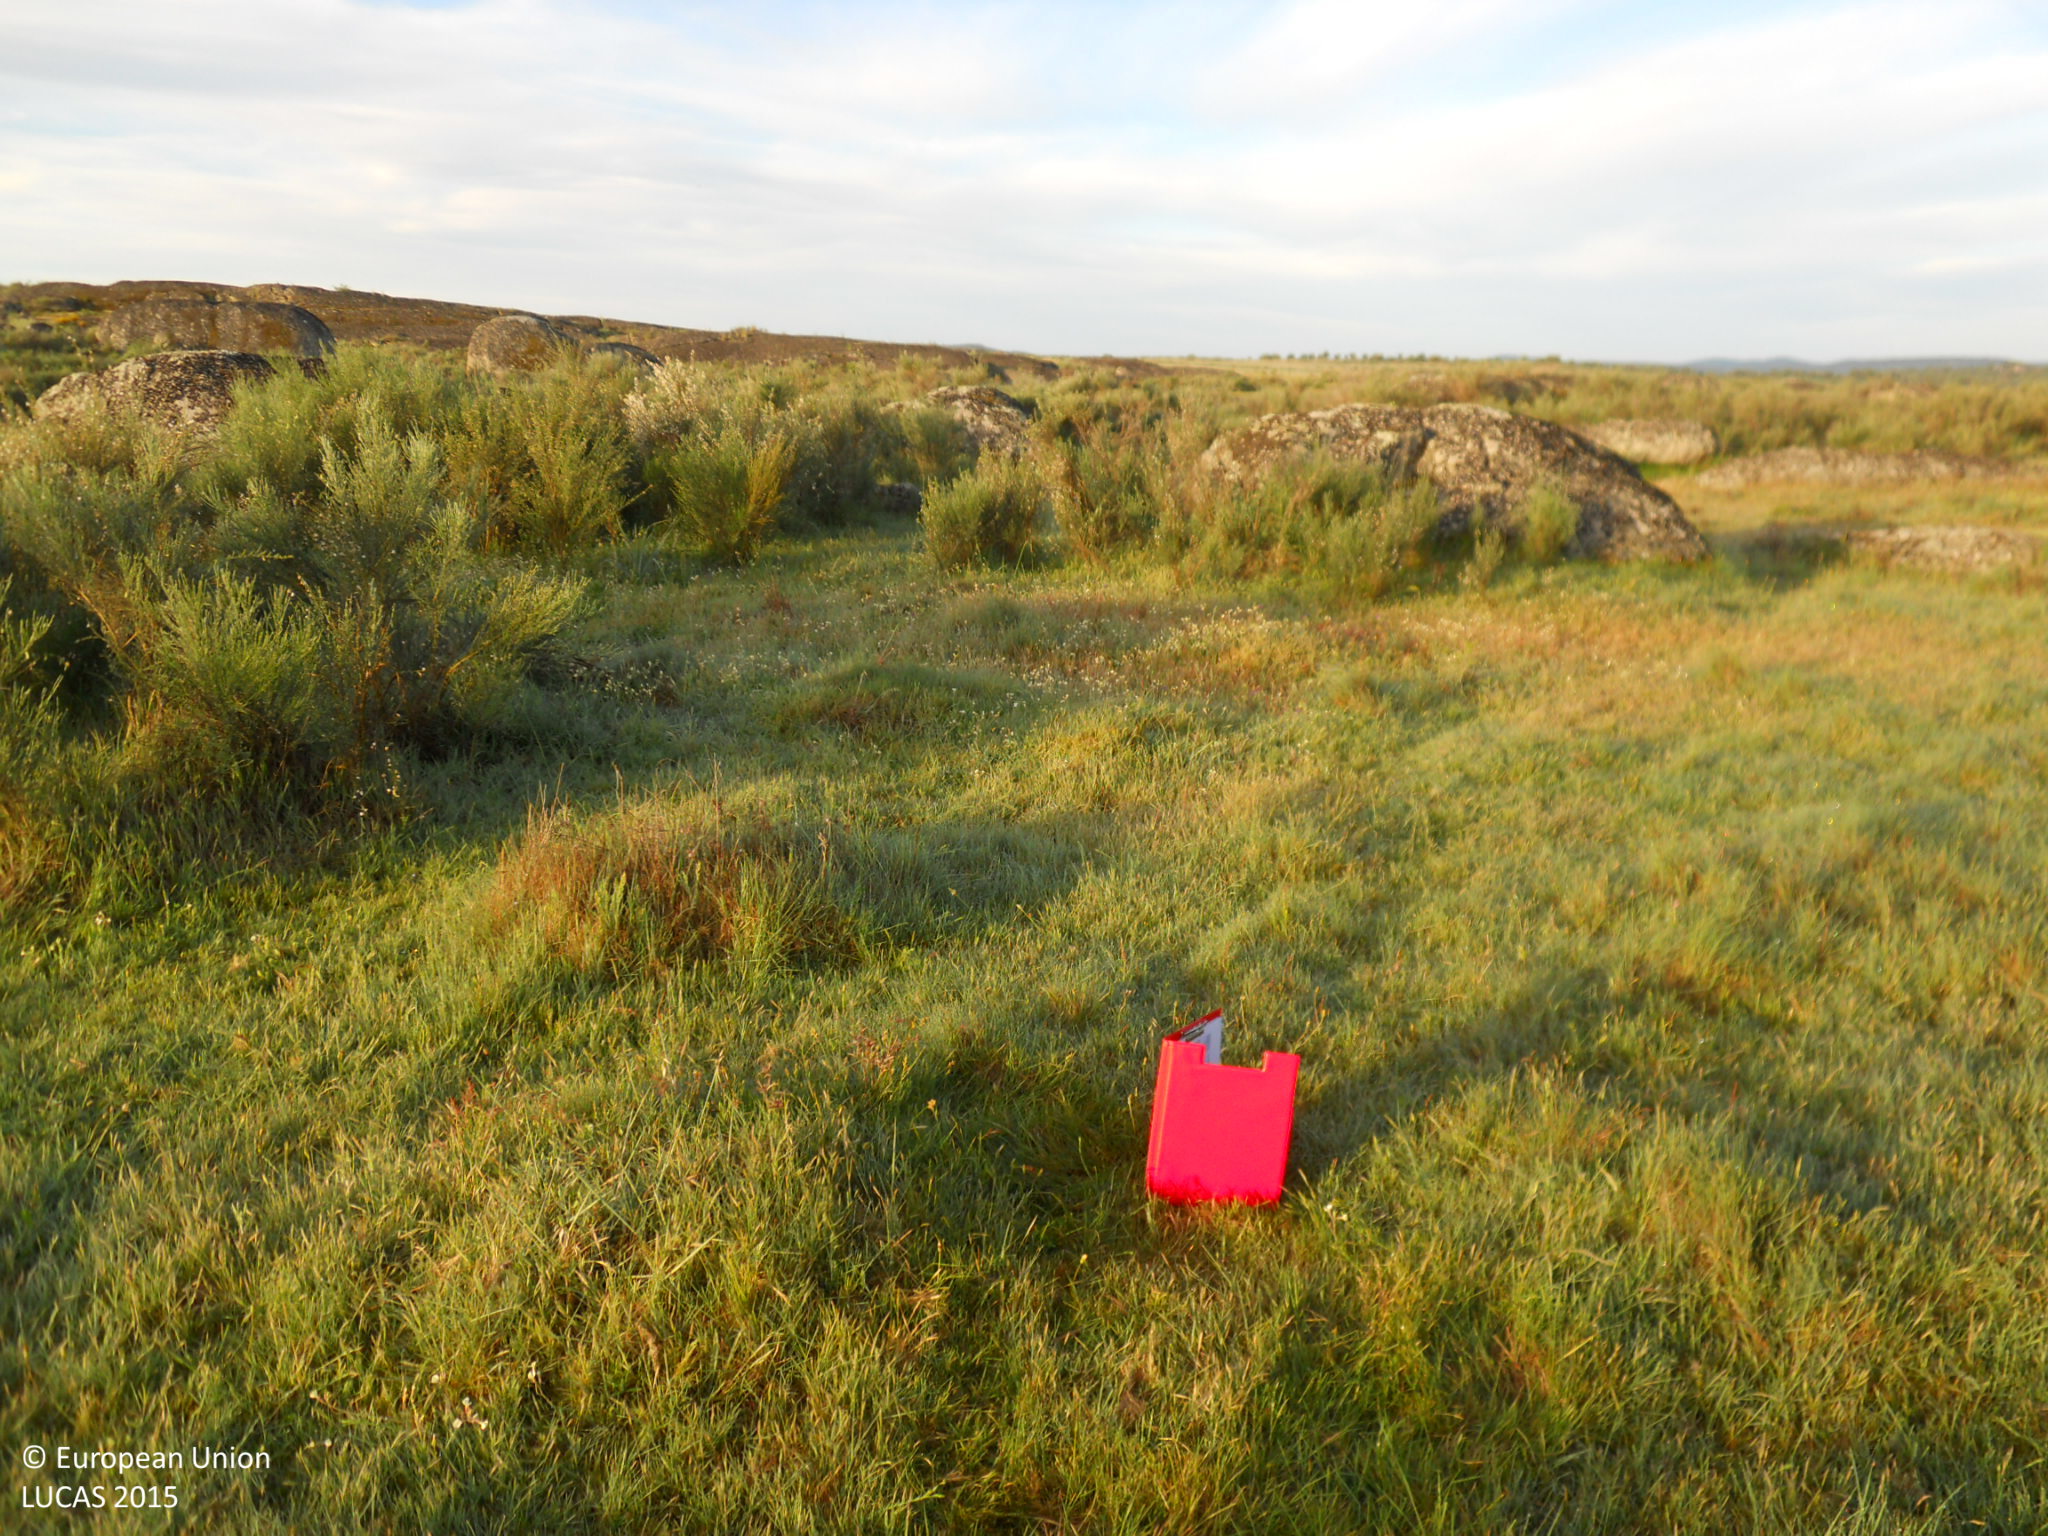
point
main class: Grassland
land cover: Grassland with sparse tree/shrub cover
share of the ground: > 75 %
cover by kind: herbaceous plants 90 %, broadleaved forest trees 5 %, shrubs 5 %
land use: Agriculture (excluding fallow land and kitchen gardens)
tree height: < 5 m
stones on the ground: 10 - 25 %
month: April
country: ES
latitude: 39.2769
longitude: -7.0614
